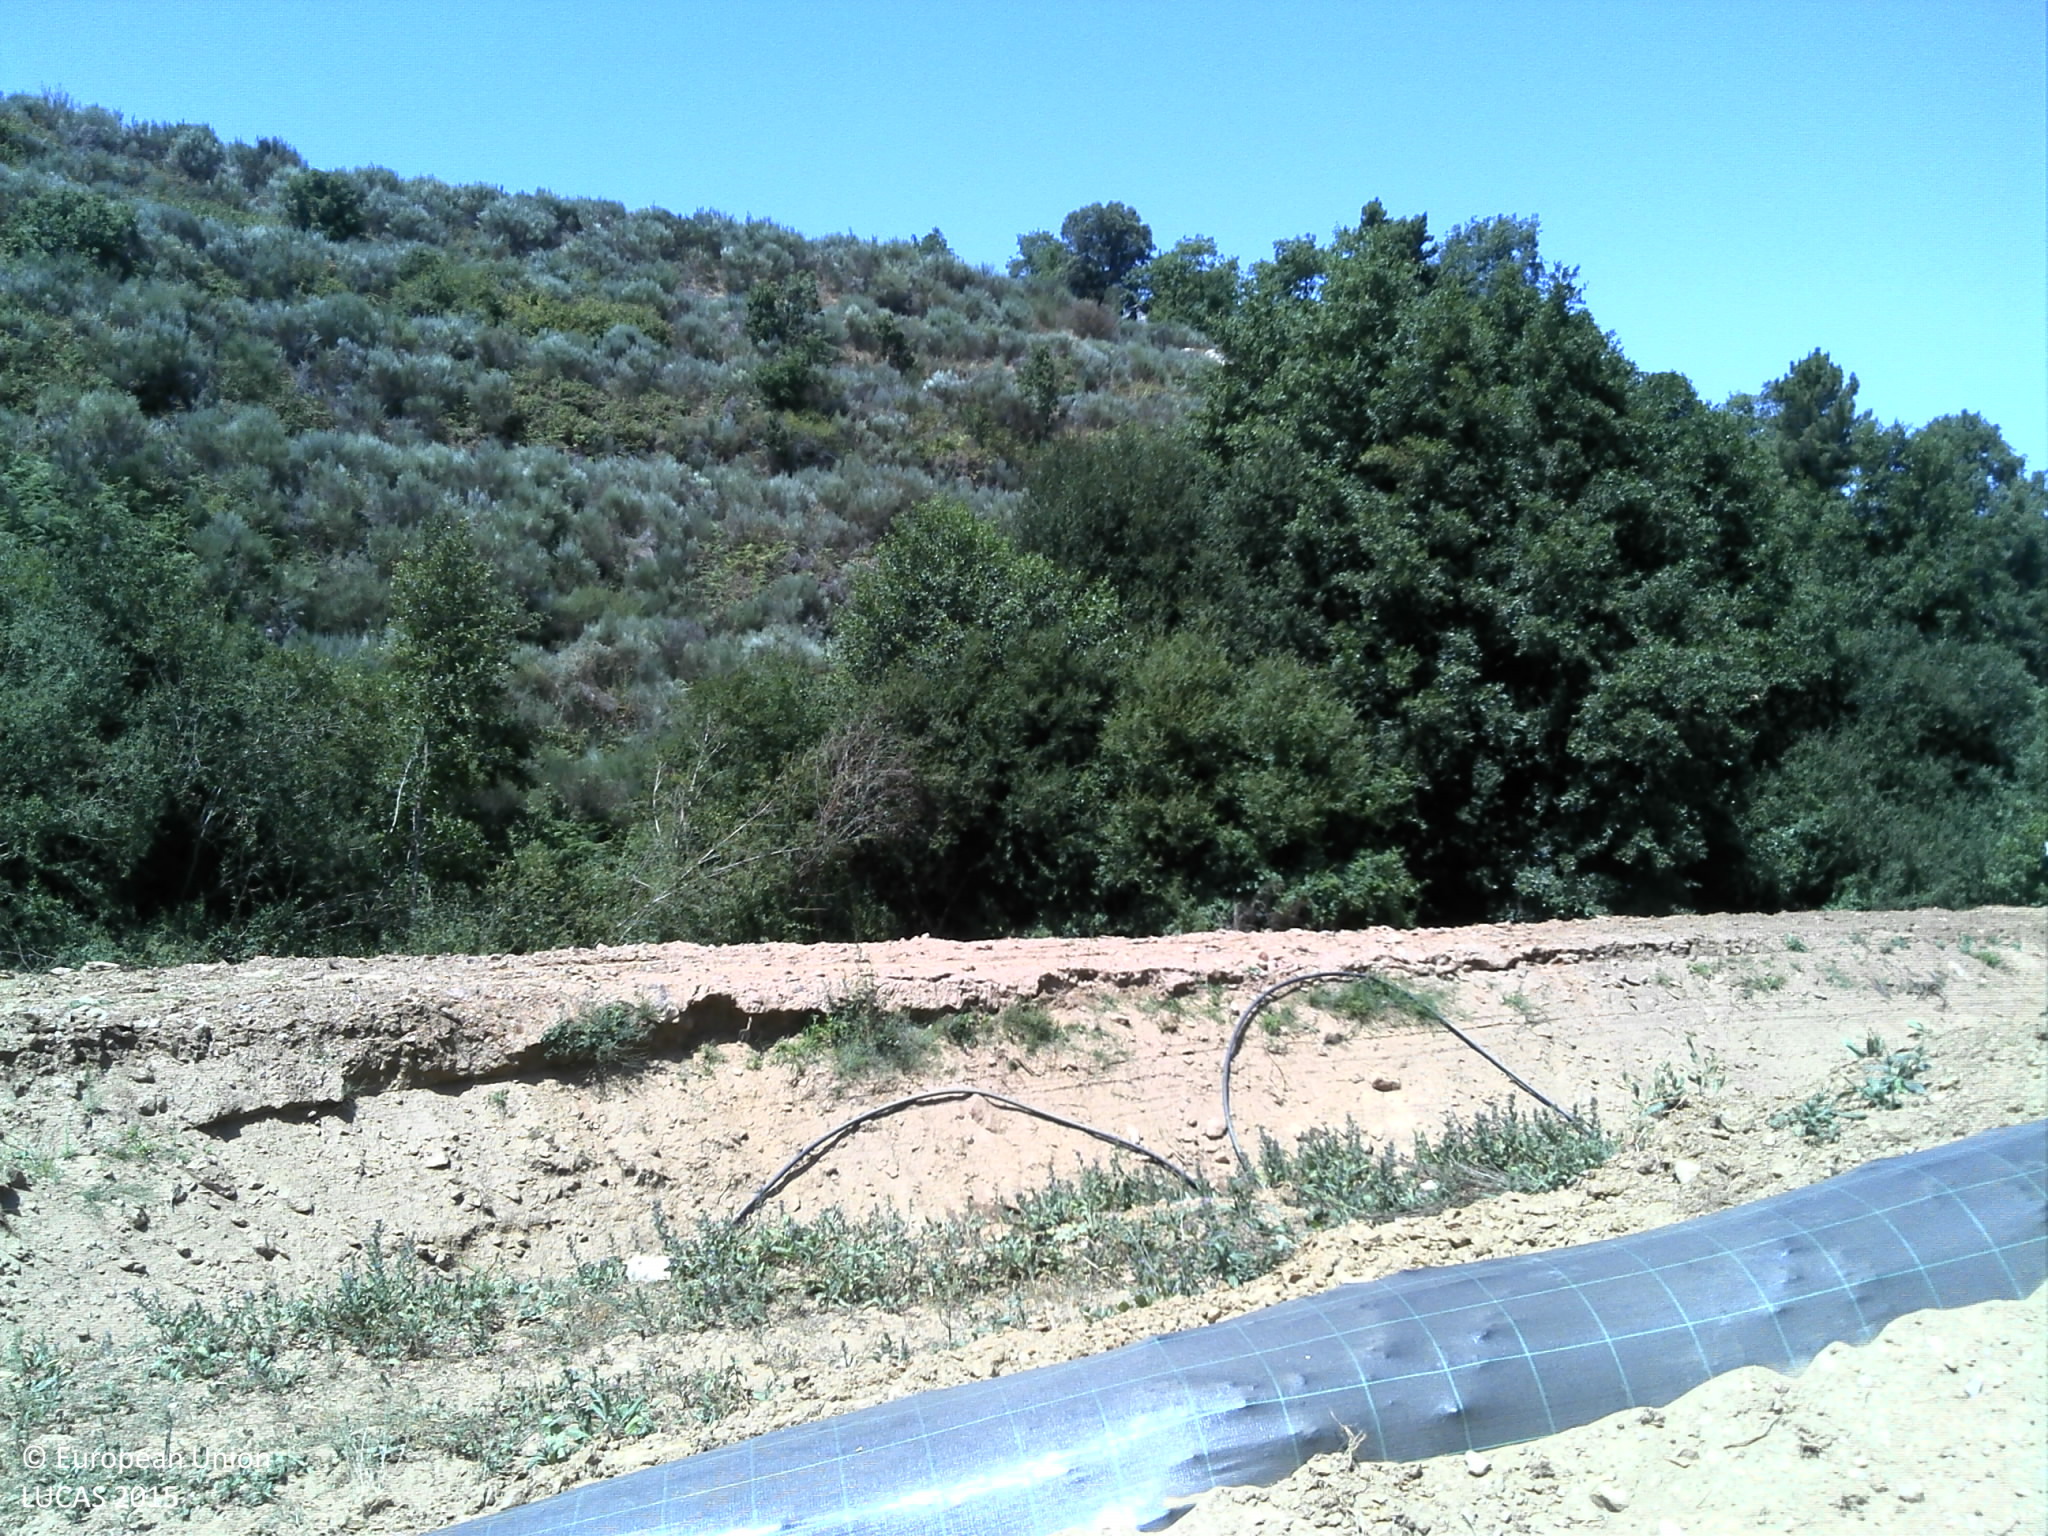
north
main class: Grassland
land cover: Spontaneously vegetated surfaces
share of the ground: < 10 %
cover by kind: unconsolidated bare surface 90 %, herbaceous plants 10 %
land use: Fallow land
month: July
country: PT
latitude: 41.0592
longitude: -7.4073
